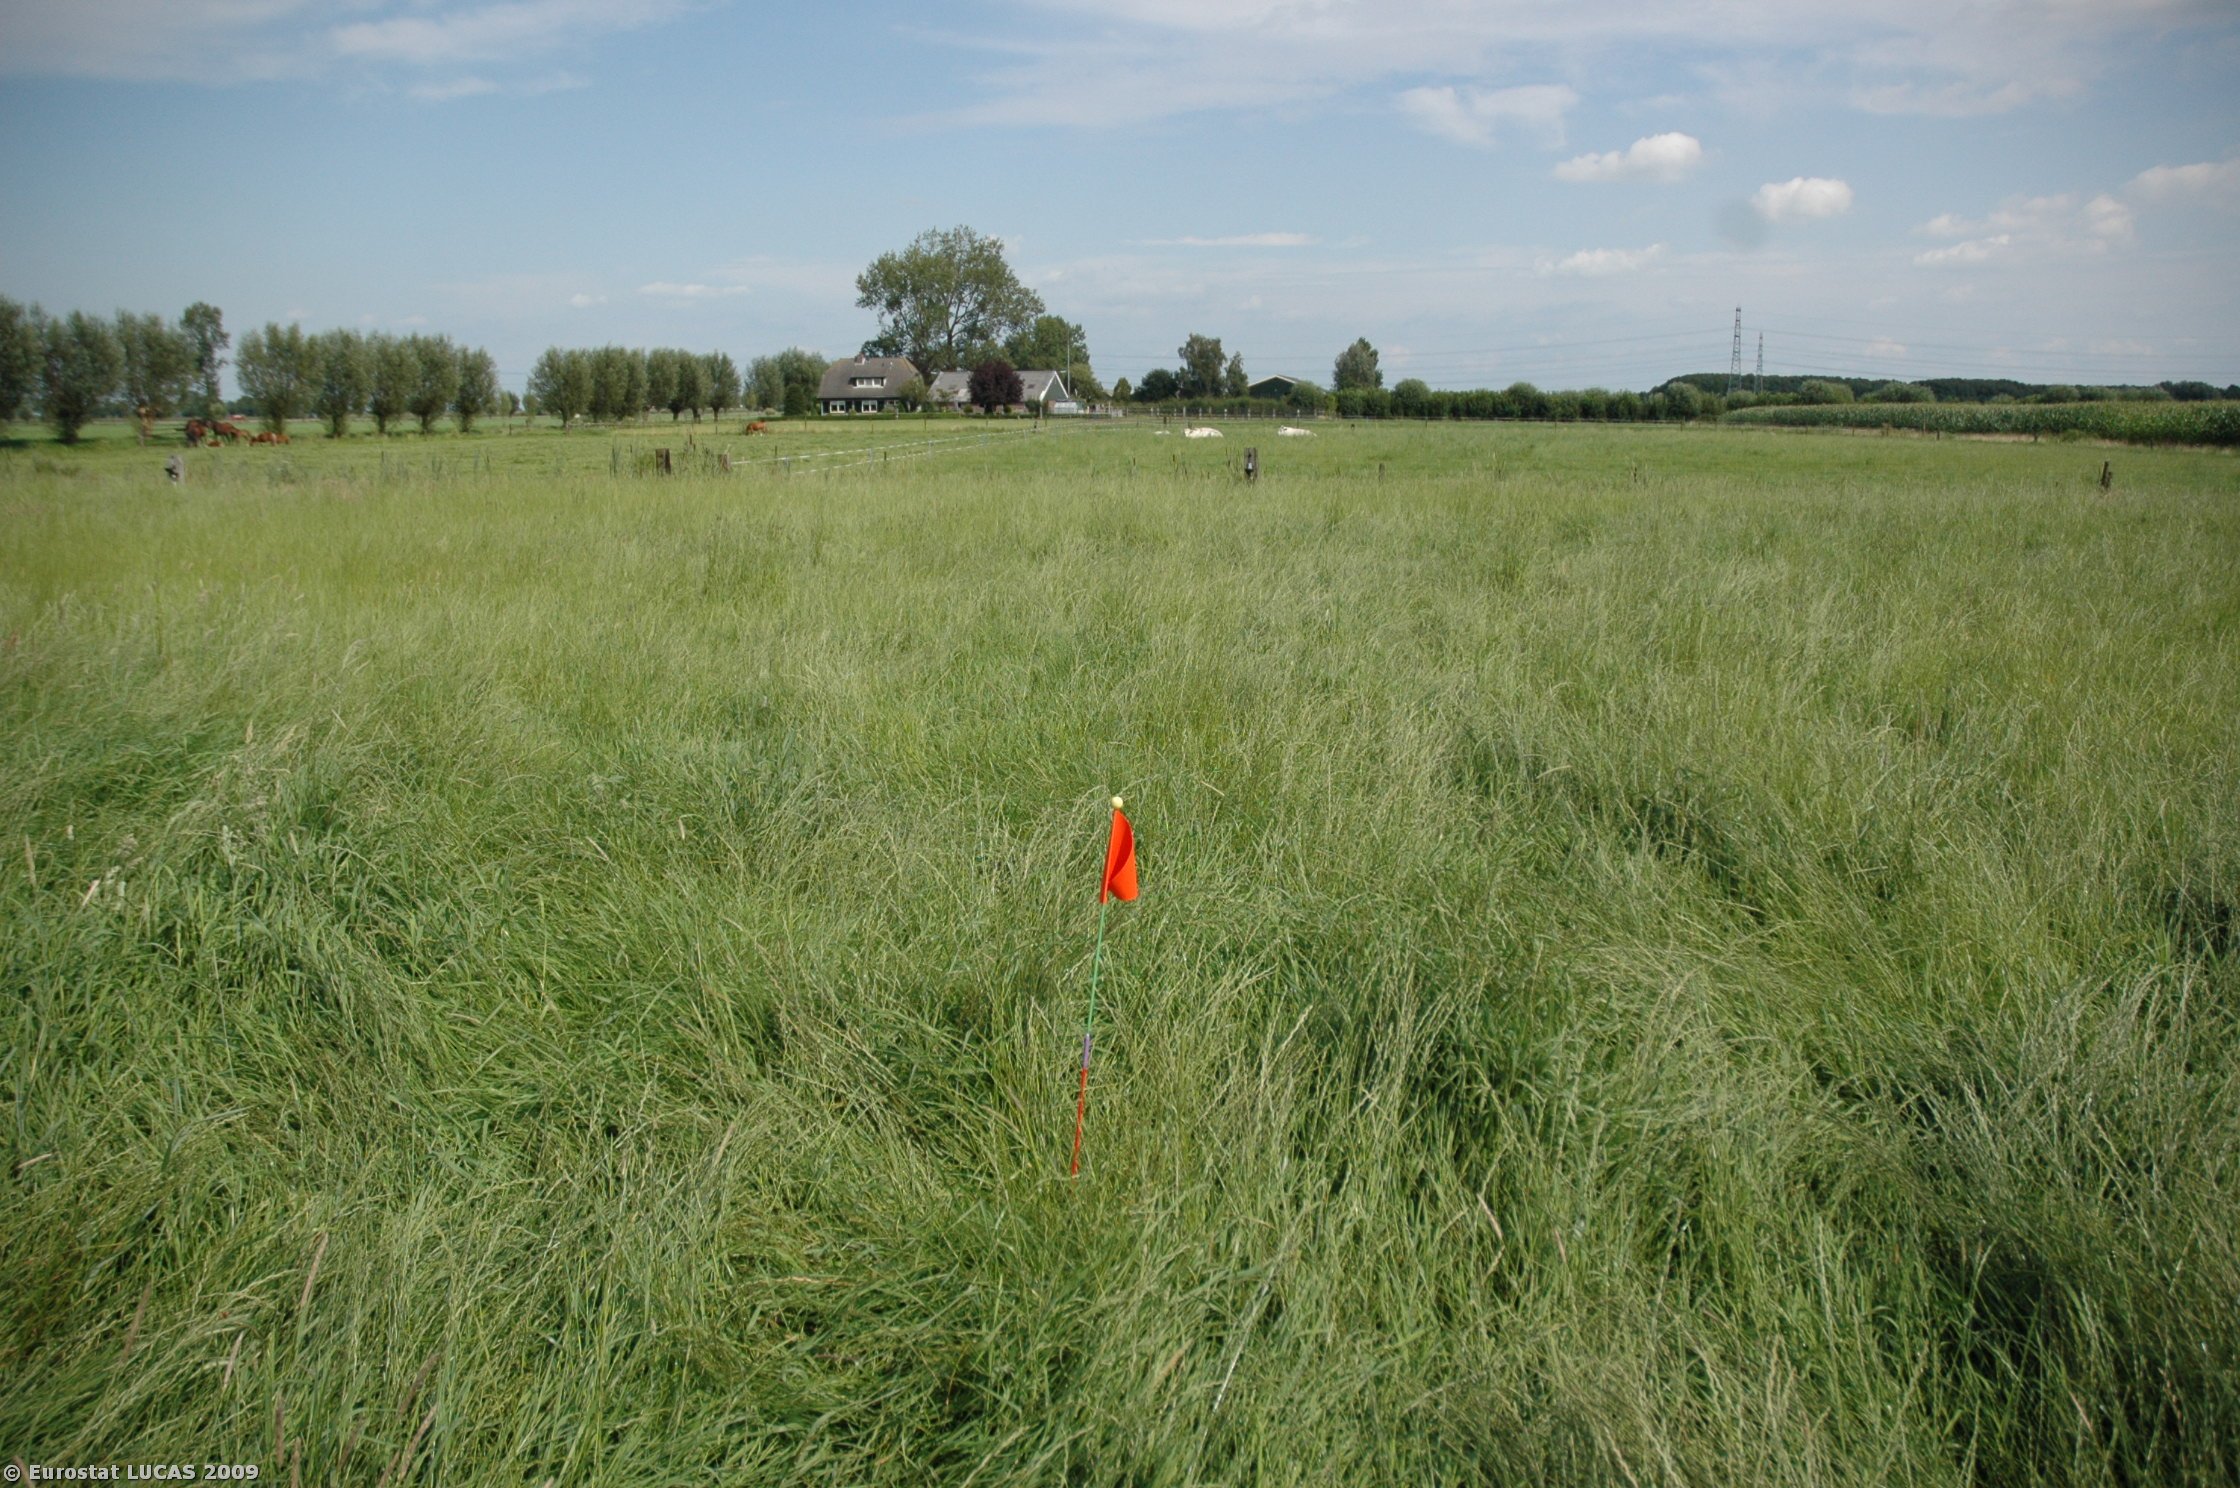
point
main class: Grassland
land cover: Grassland without tree/shrub cover
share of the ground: > 75 %
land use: Agriculture (excluding fallow land and kitchen gardens)
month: August
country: NL
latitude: 52.4026
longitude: 6.0749
